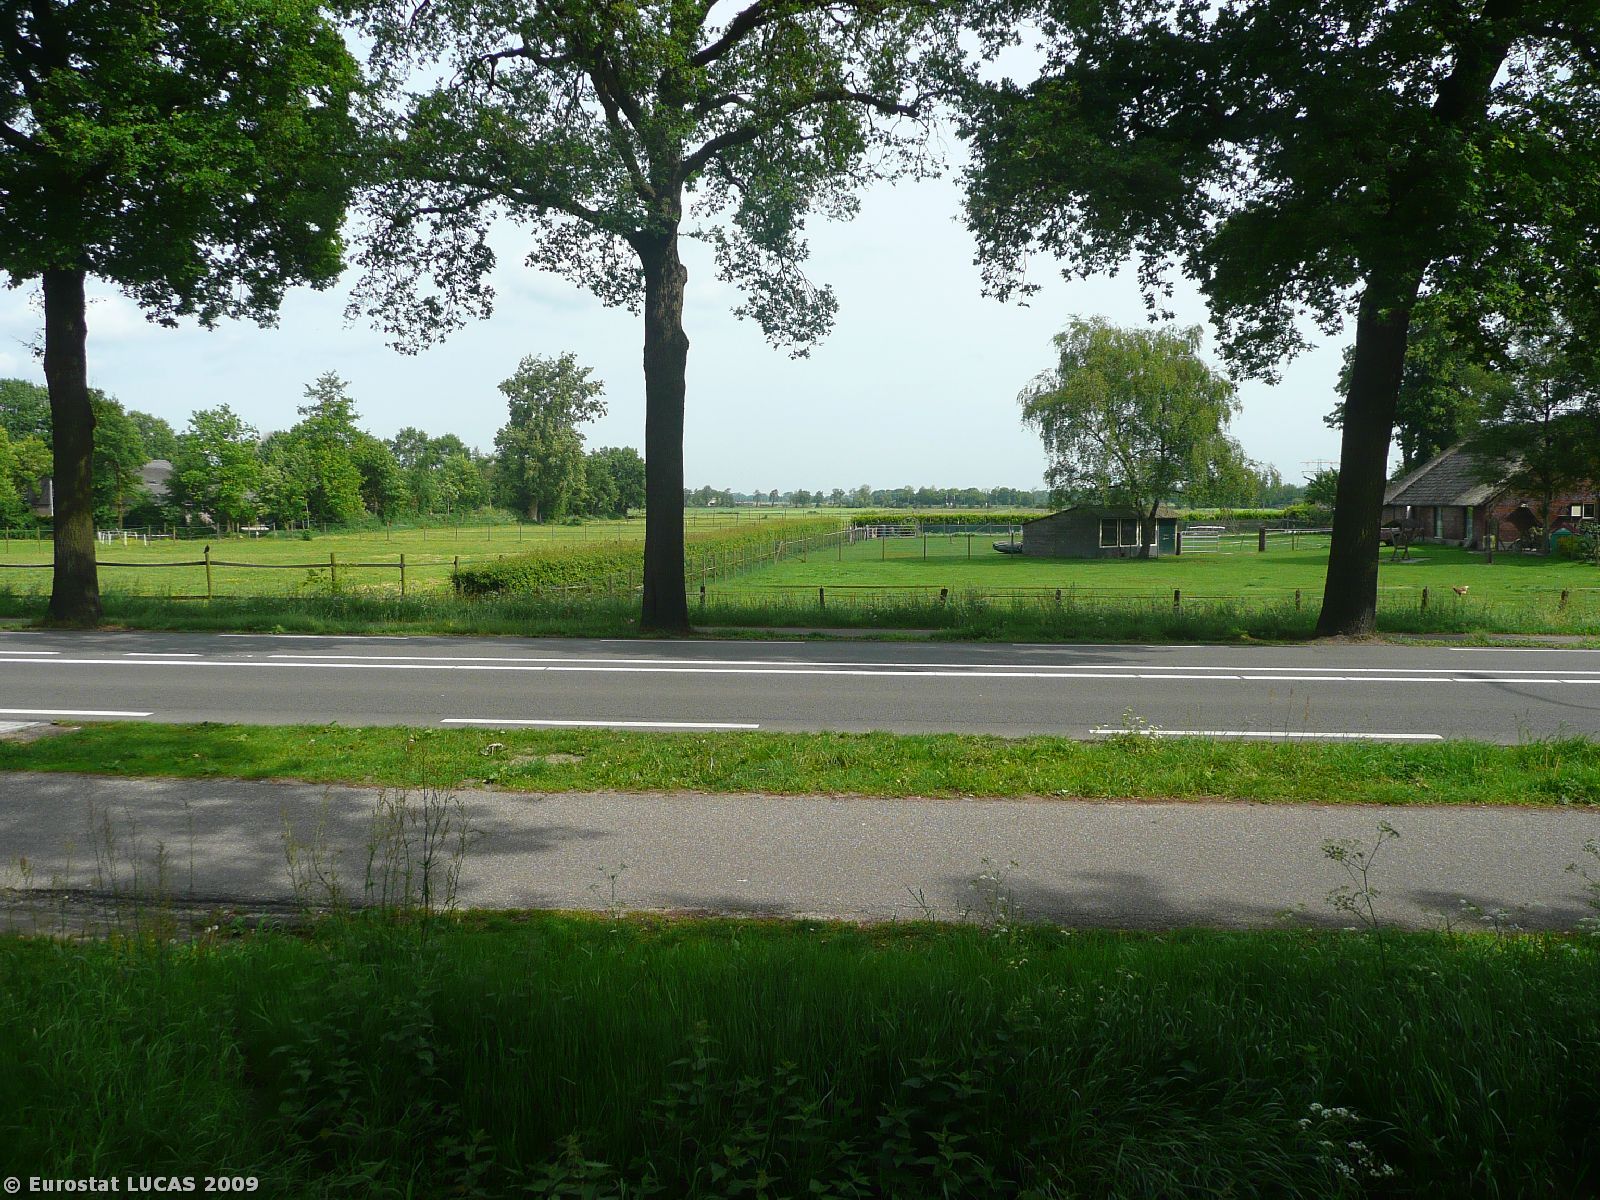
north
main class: Woodland
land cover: Coniferous woodland
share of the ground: > 75 %
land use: Residential
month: May
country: NL
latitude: 52.1598
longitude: 5.3349
